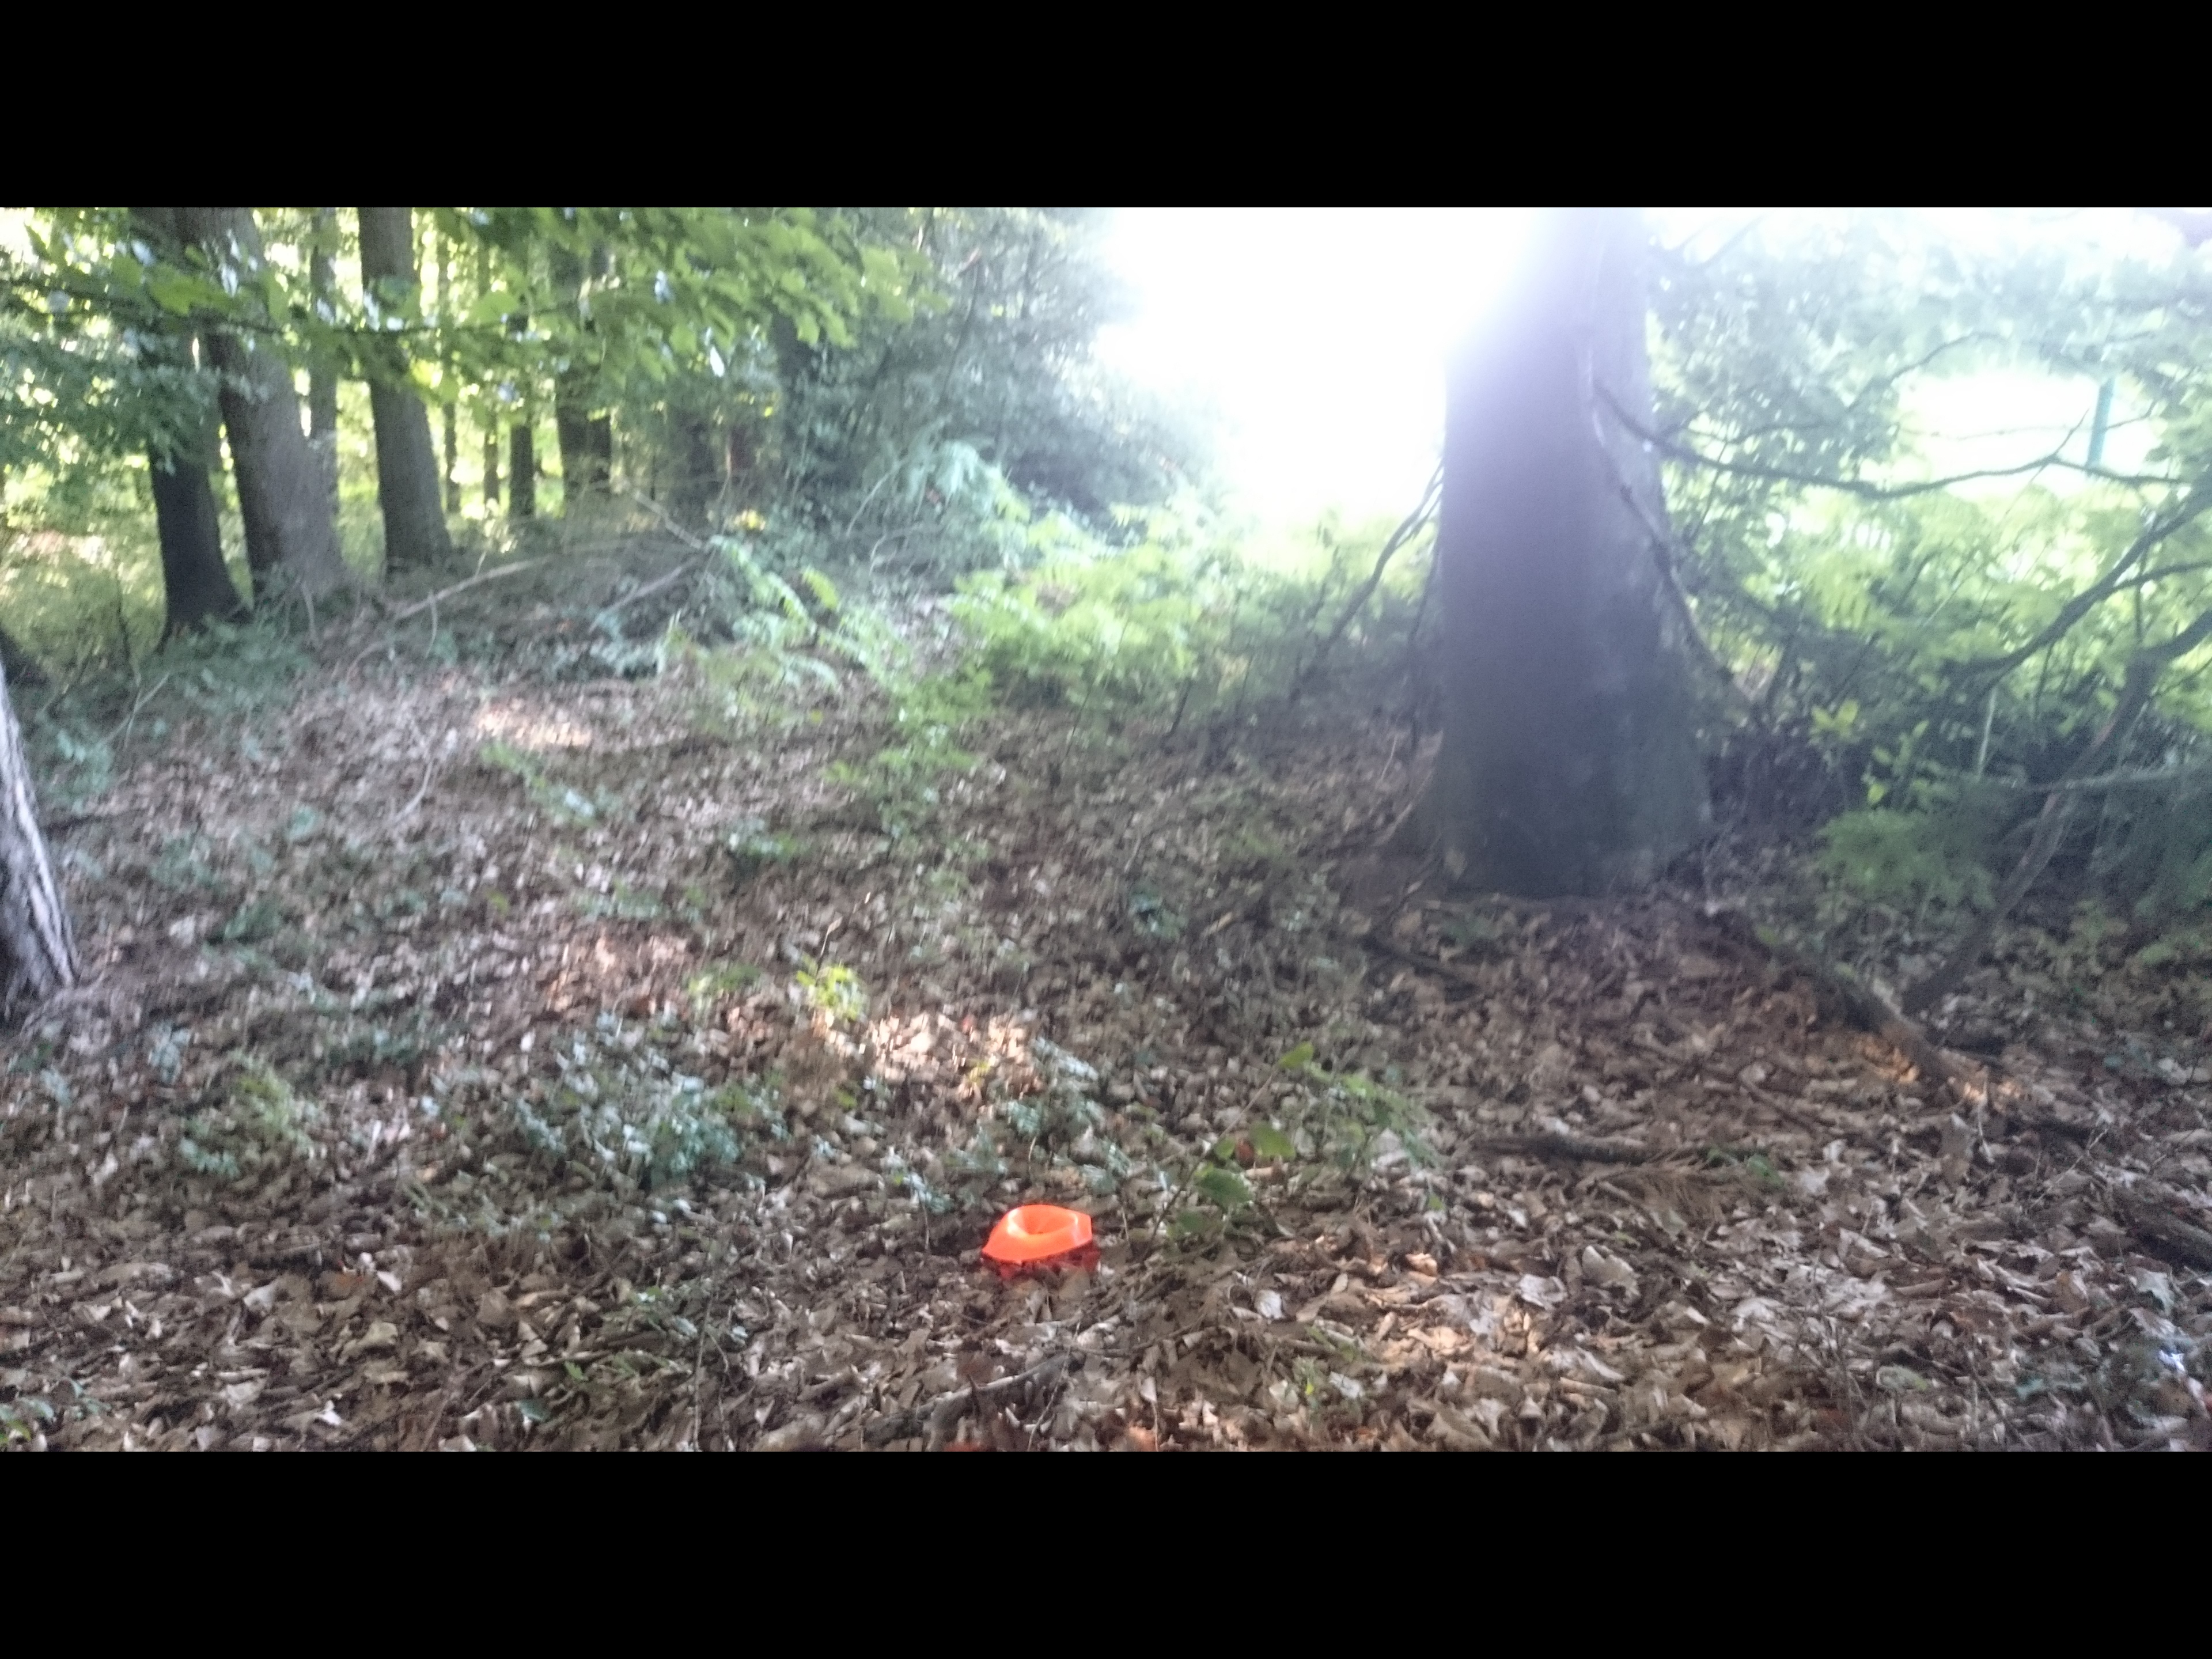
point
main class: Woodland
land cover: Broadleaved woodland
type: mountainous beech forest
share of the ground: > 75 %
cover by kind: broadleaved forest trees 80 %, coniferous forest trees 10 %, unconsolidated bare surface 10 %
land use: Forestry
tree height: > 5 m
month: July
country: AT
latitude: 47.2119
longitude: 15.6649
